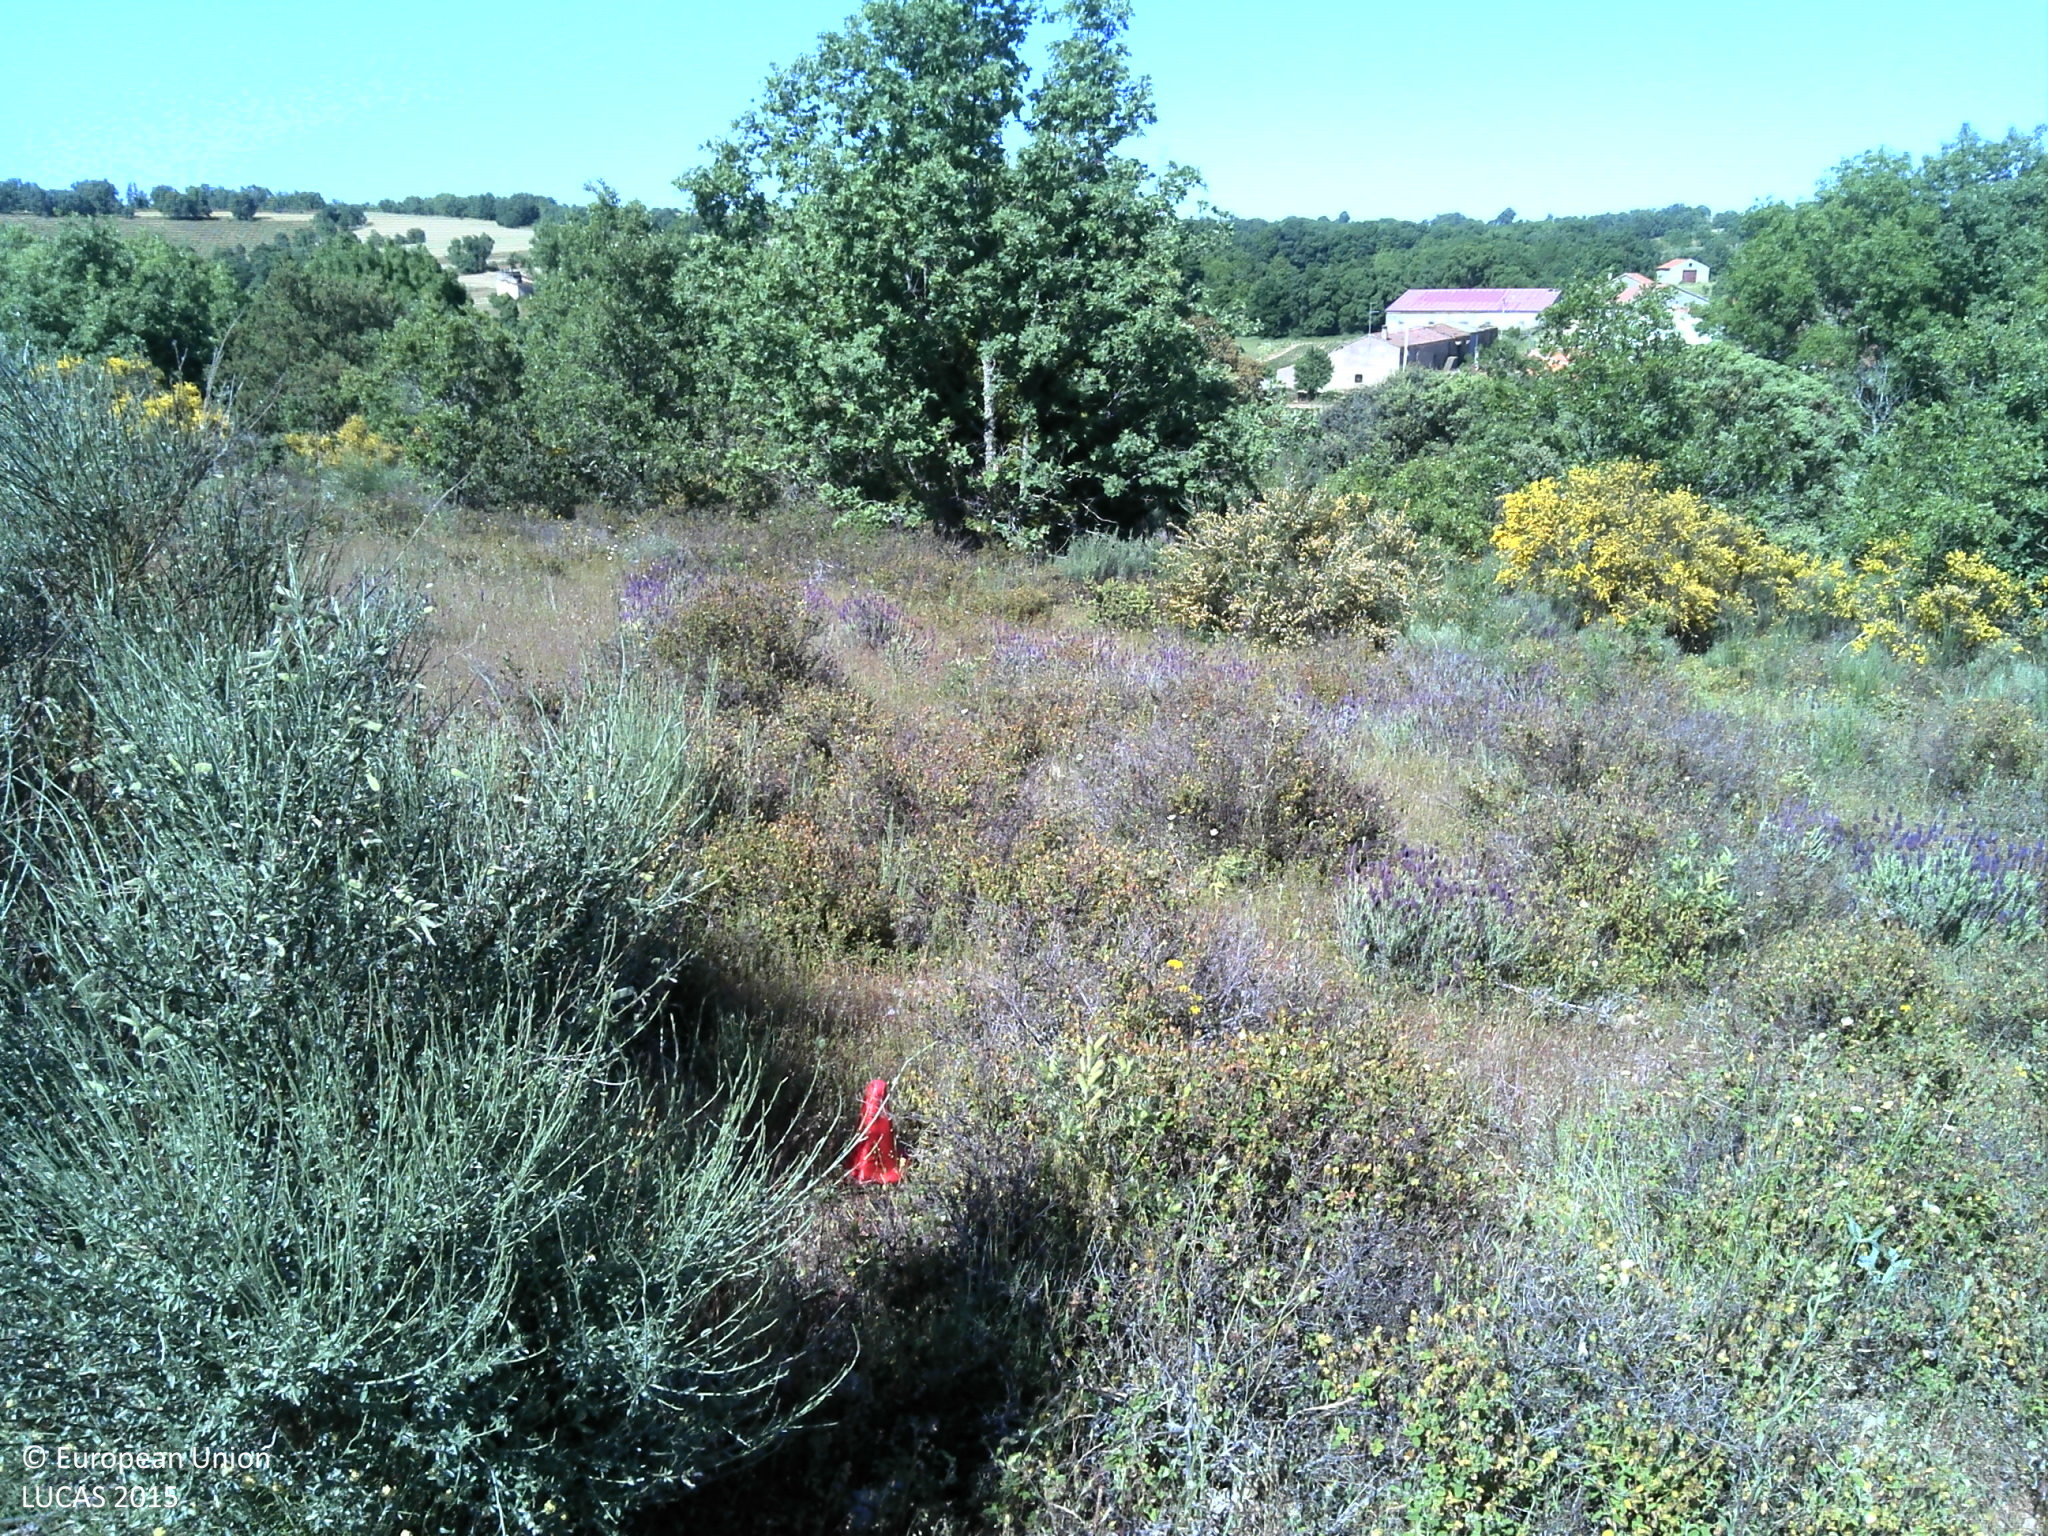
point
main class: Shrubland
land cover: Shrubland without tree cover
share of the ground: 25 - 50 %
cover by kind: shrubs 50 %, unconsolidated bare surface 30 %, herbaceous plants 20 %
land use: Abandoned areas
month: May
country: PT
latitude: 41.4980
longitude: -6.3551
